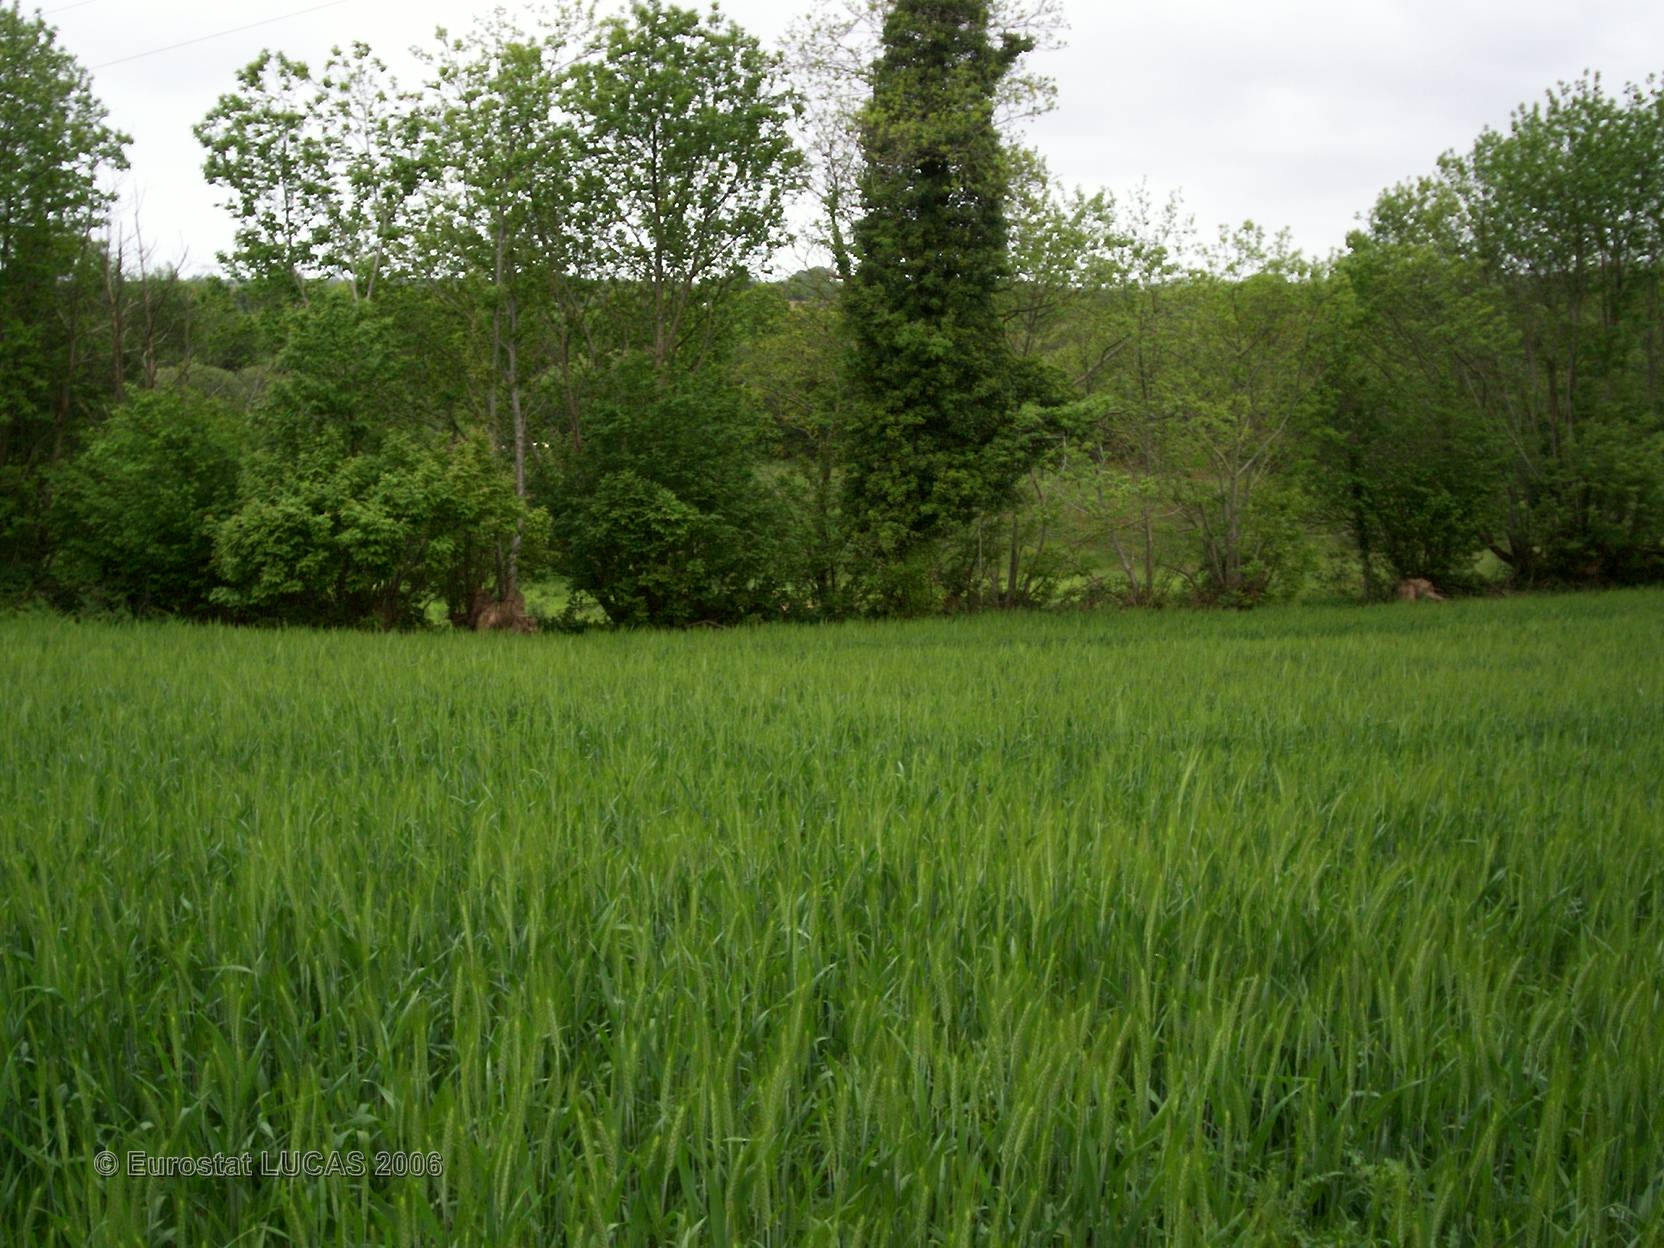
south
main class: Cropland
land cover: Common wheat
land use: Agriculture (excluding fallow land and kitchen gardens)
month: May
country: FR
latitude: 47.9242
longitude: -3.8814
